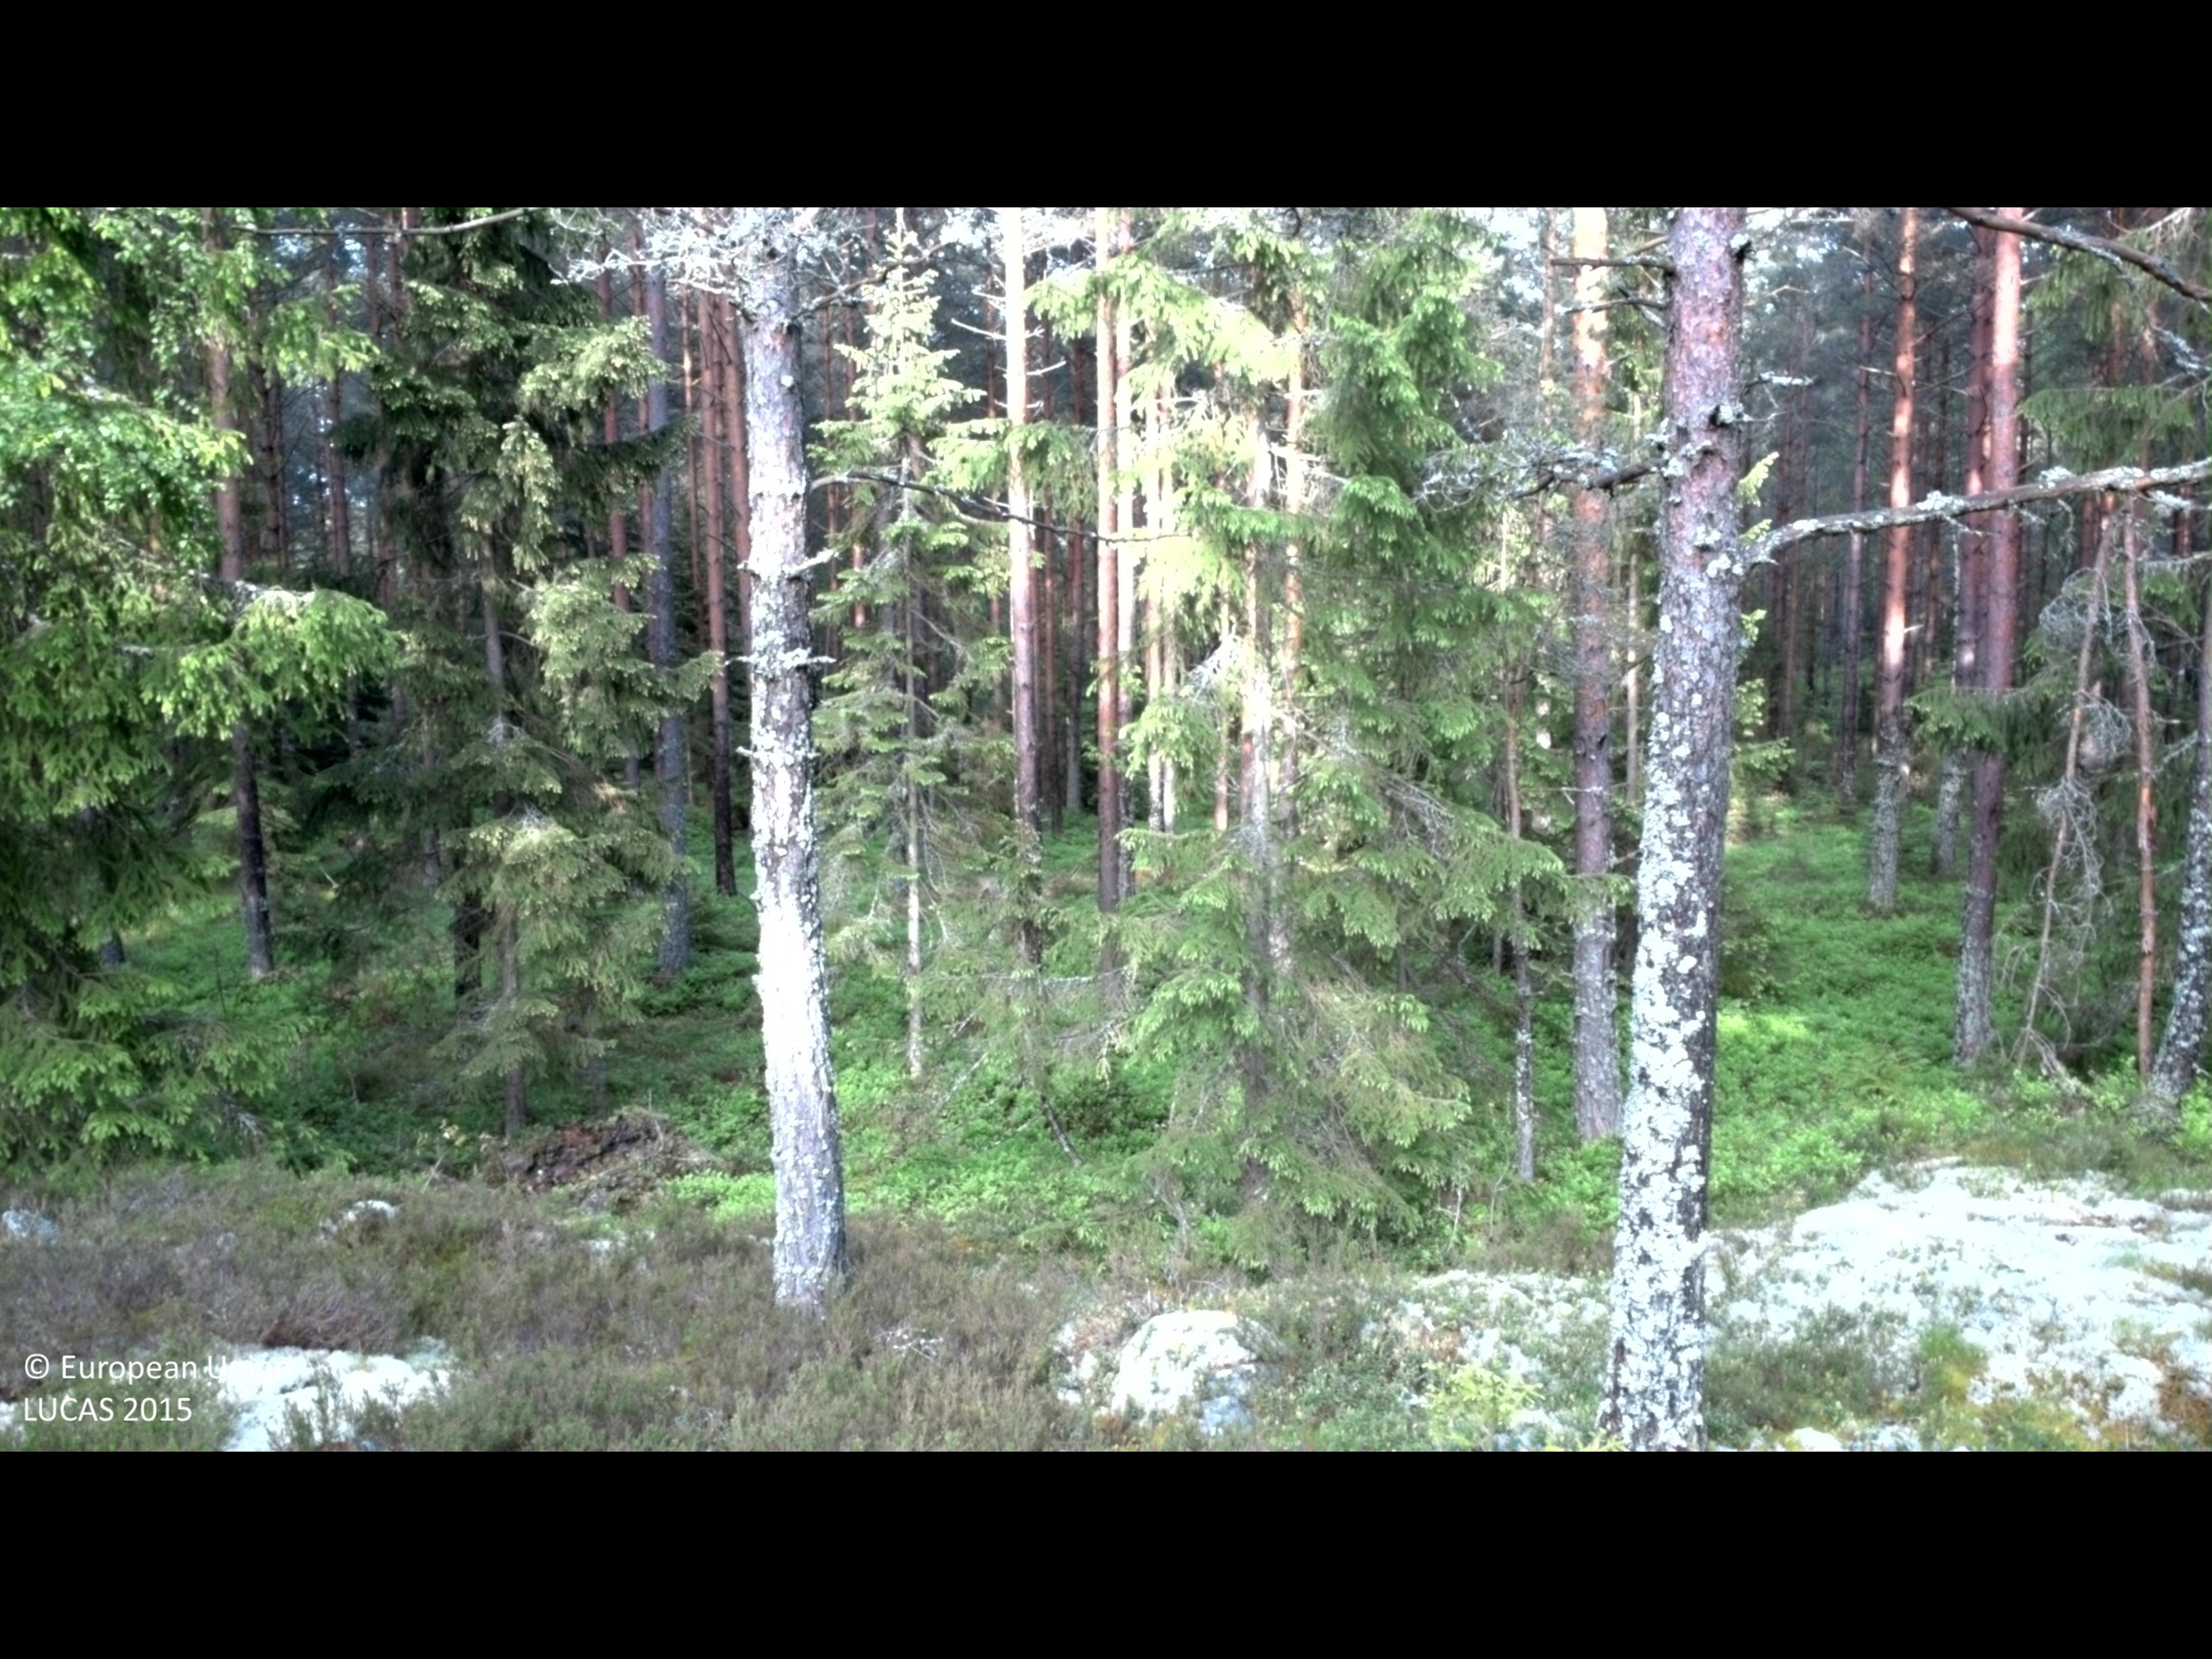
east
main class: Woodland
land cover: Pine dominated coniferous woodland
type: boreal forest
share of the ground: 25 - 50 %
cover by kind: coniferous forest trees 45 %, lichens and mosses 25 %, shrubs 15 %, broadleaved forest trees 5 %, herbaceous plants 5 %, consolidated bare surface 5 %
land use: Forestry
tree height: > 5 m
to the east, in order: Pine dominated coniferous woodland; Other bare soil; Pine dominated coniferous woodland; Shrubland with sparse tree cover; Pine dominated mixed woodland; Pine dominated coniferous woodland
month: May
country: SE
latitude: 57.4299
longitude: 16.5116
